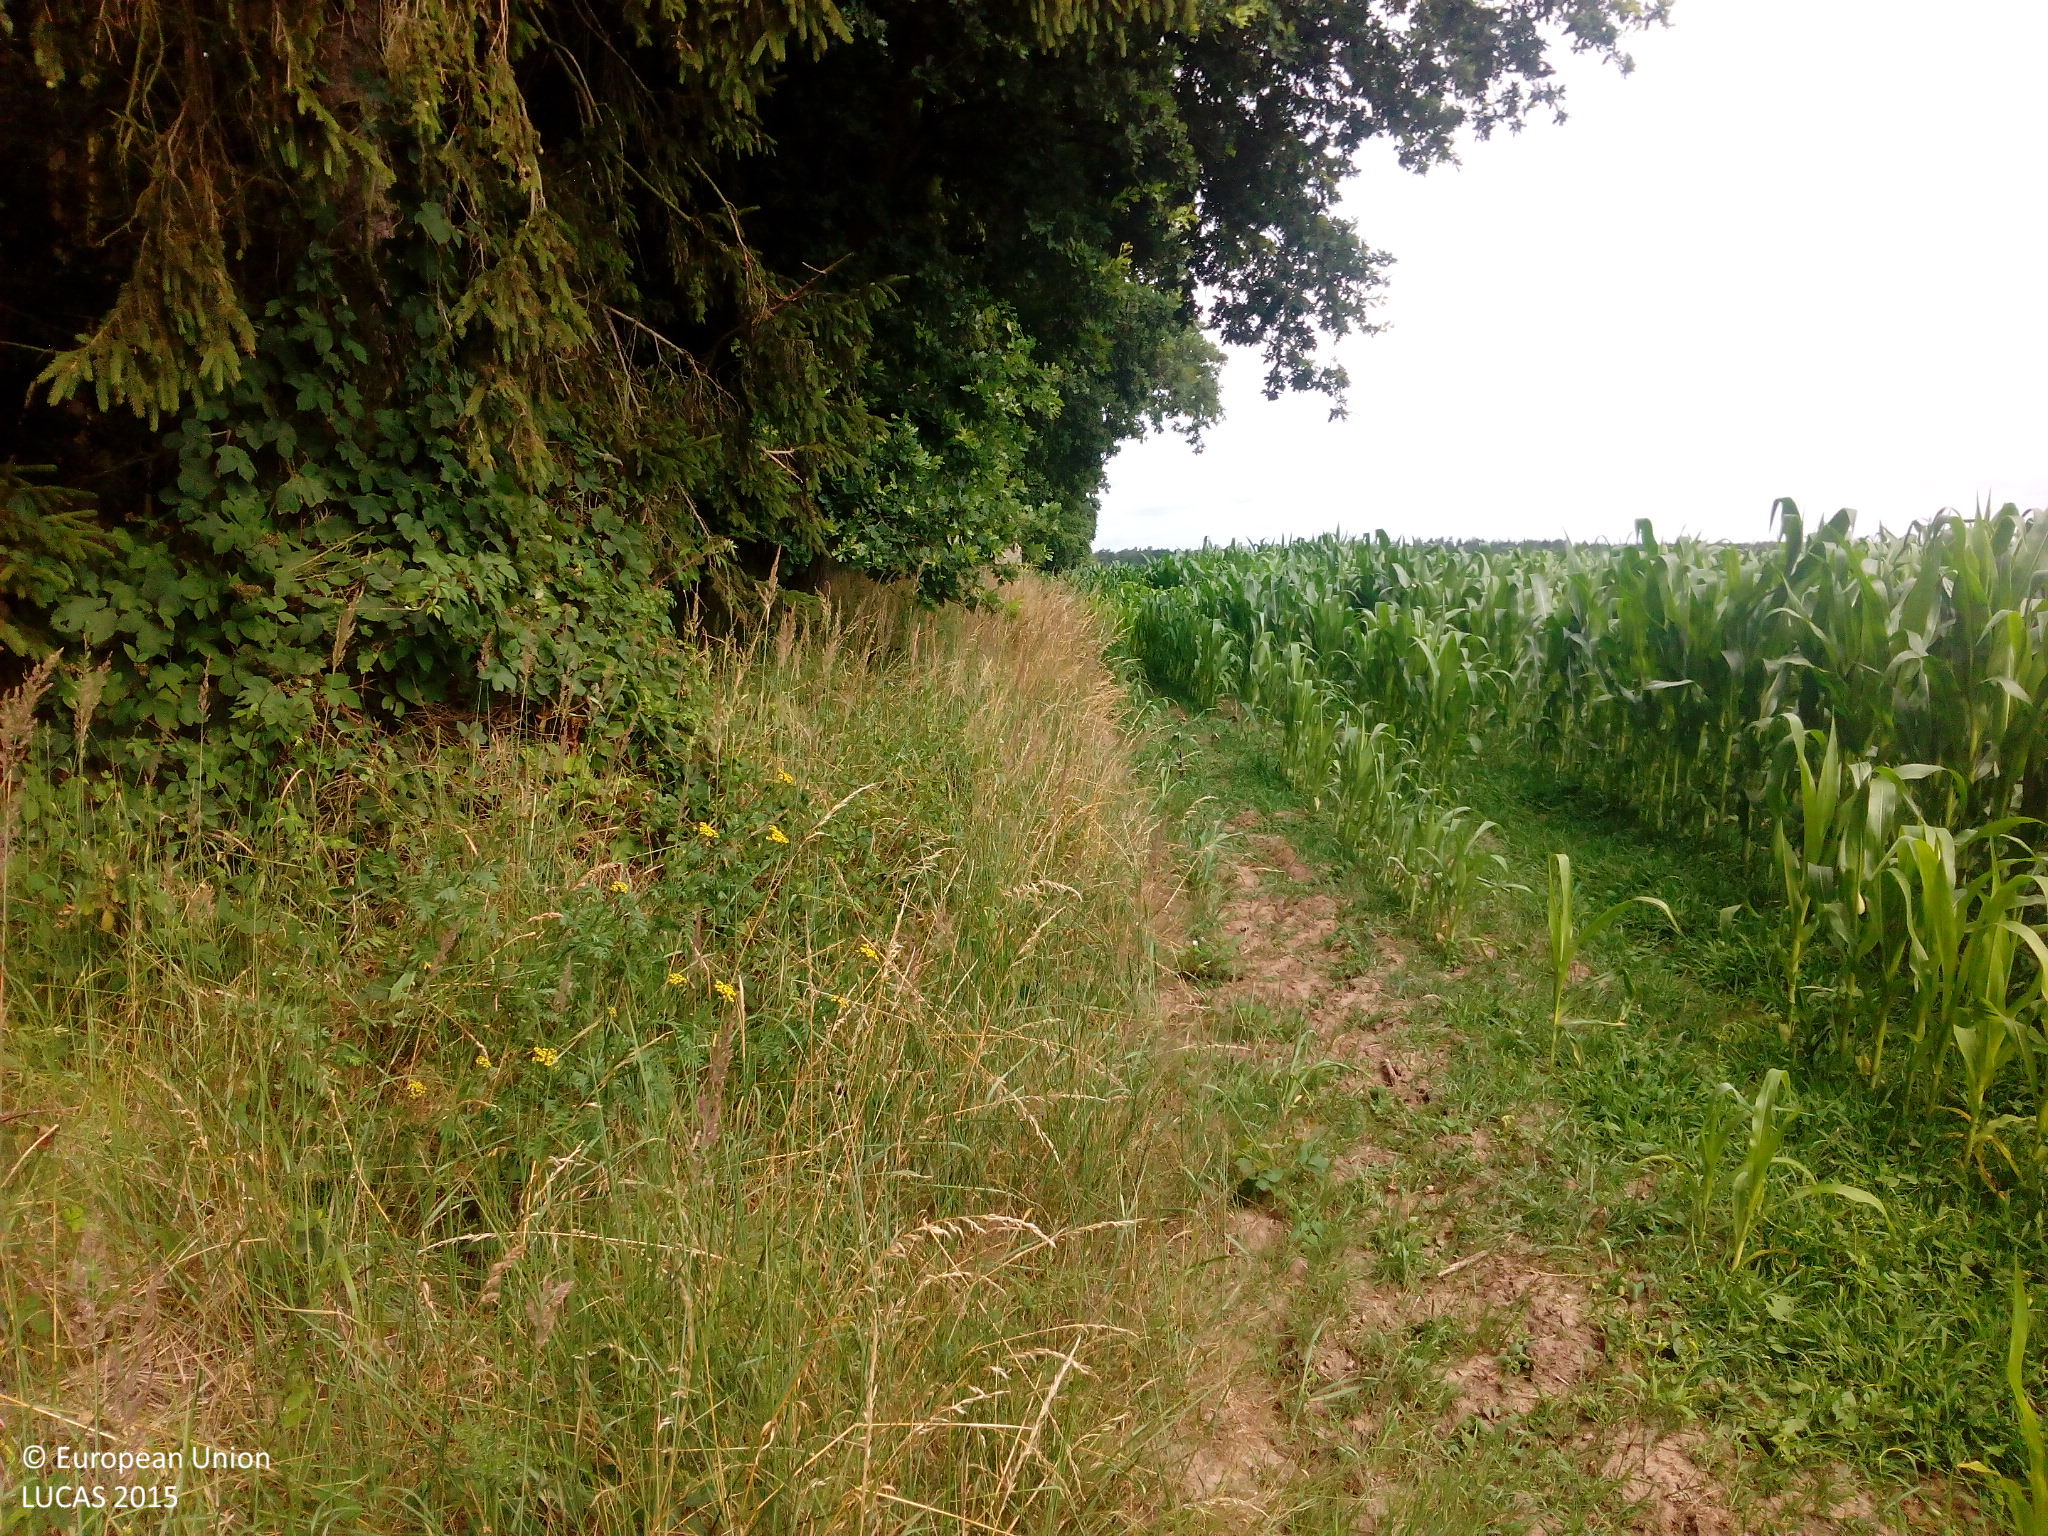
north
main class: Cropland
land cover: Maize
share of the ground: > 75 %
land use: Agriculture (excluding fallow land and kitchen gardens)
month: July
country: DE
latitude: 53.7220
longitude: 13.7431
